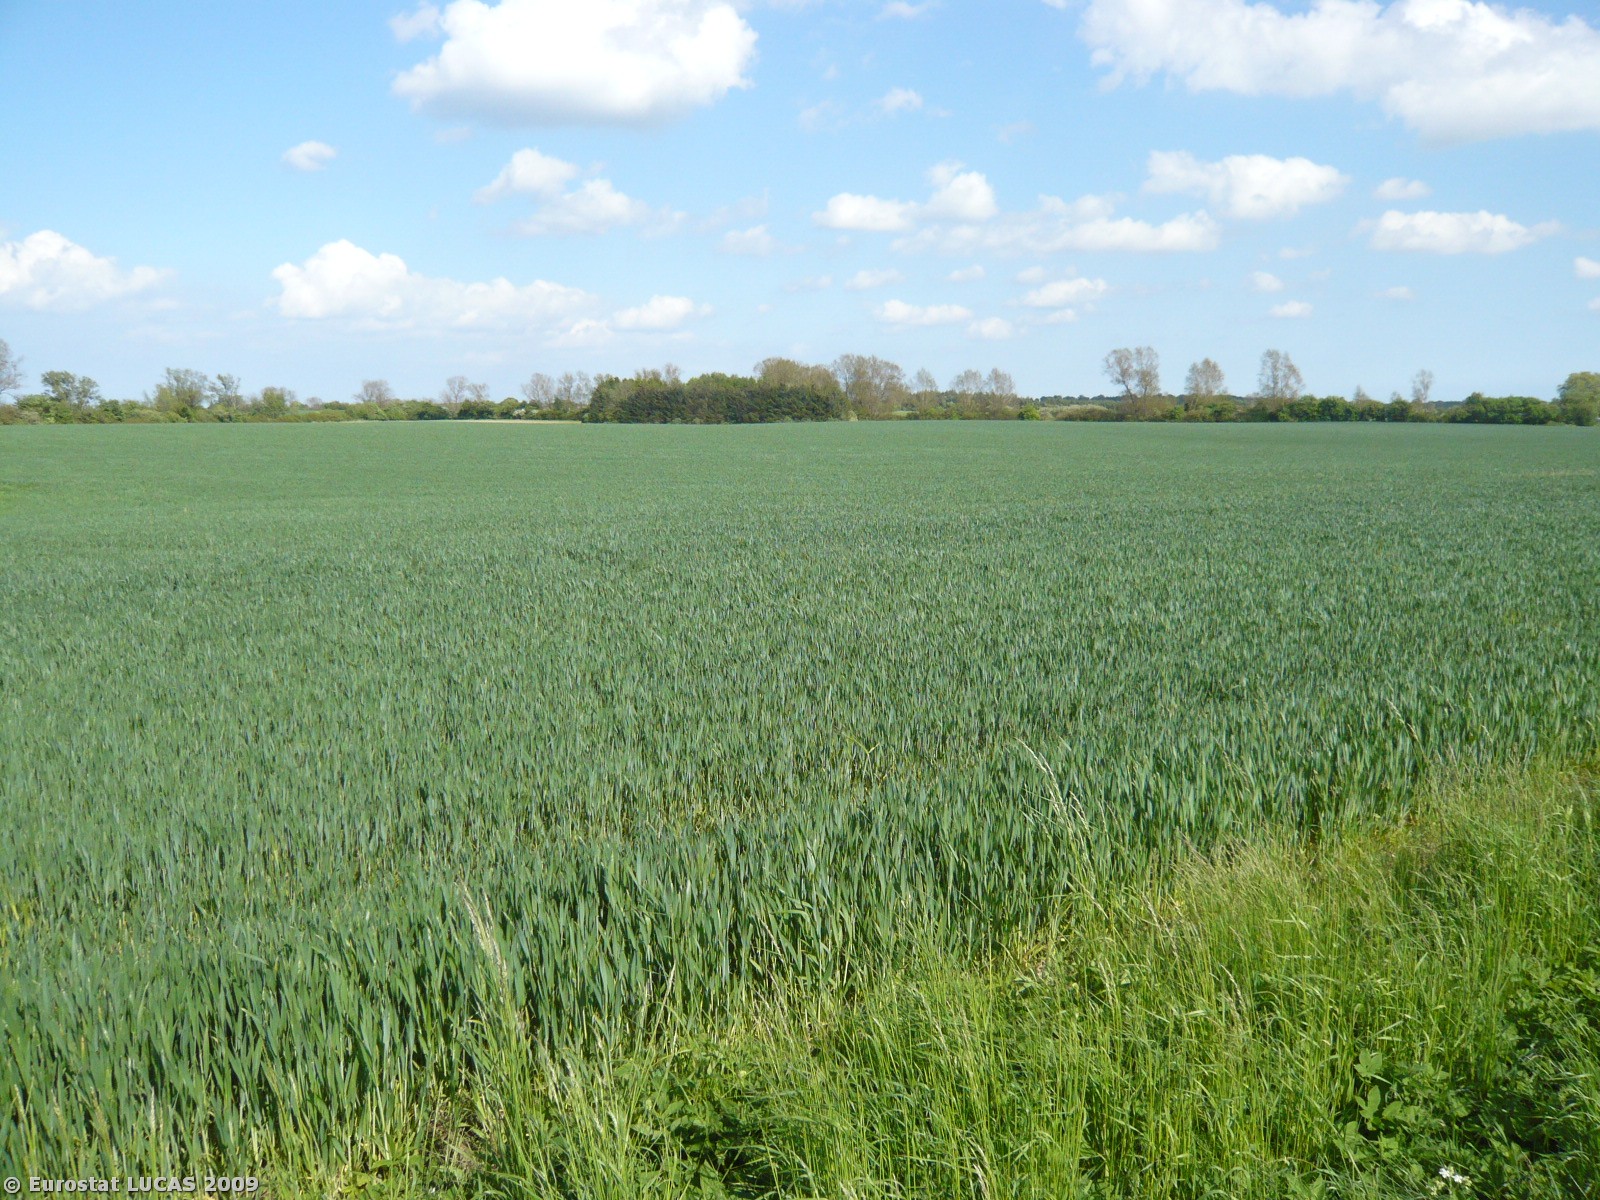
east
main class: Cropland
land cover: Common wheat
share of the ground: > 75 %
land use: Agriculture (excluding fallow land and kitchen gardens)
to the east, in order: Common wheat; Broadleaved woodland; Barley
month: May
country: DK
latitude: 55.4143
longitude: 12.1624
